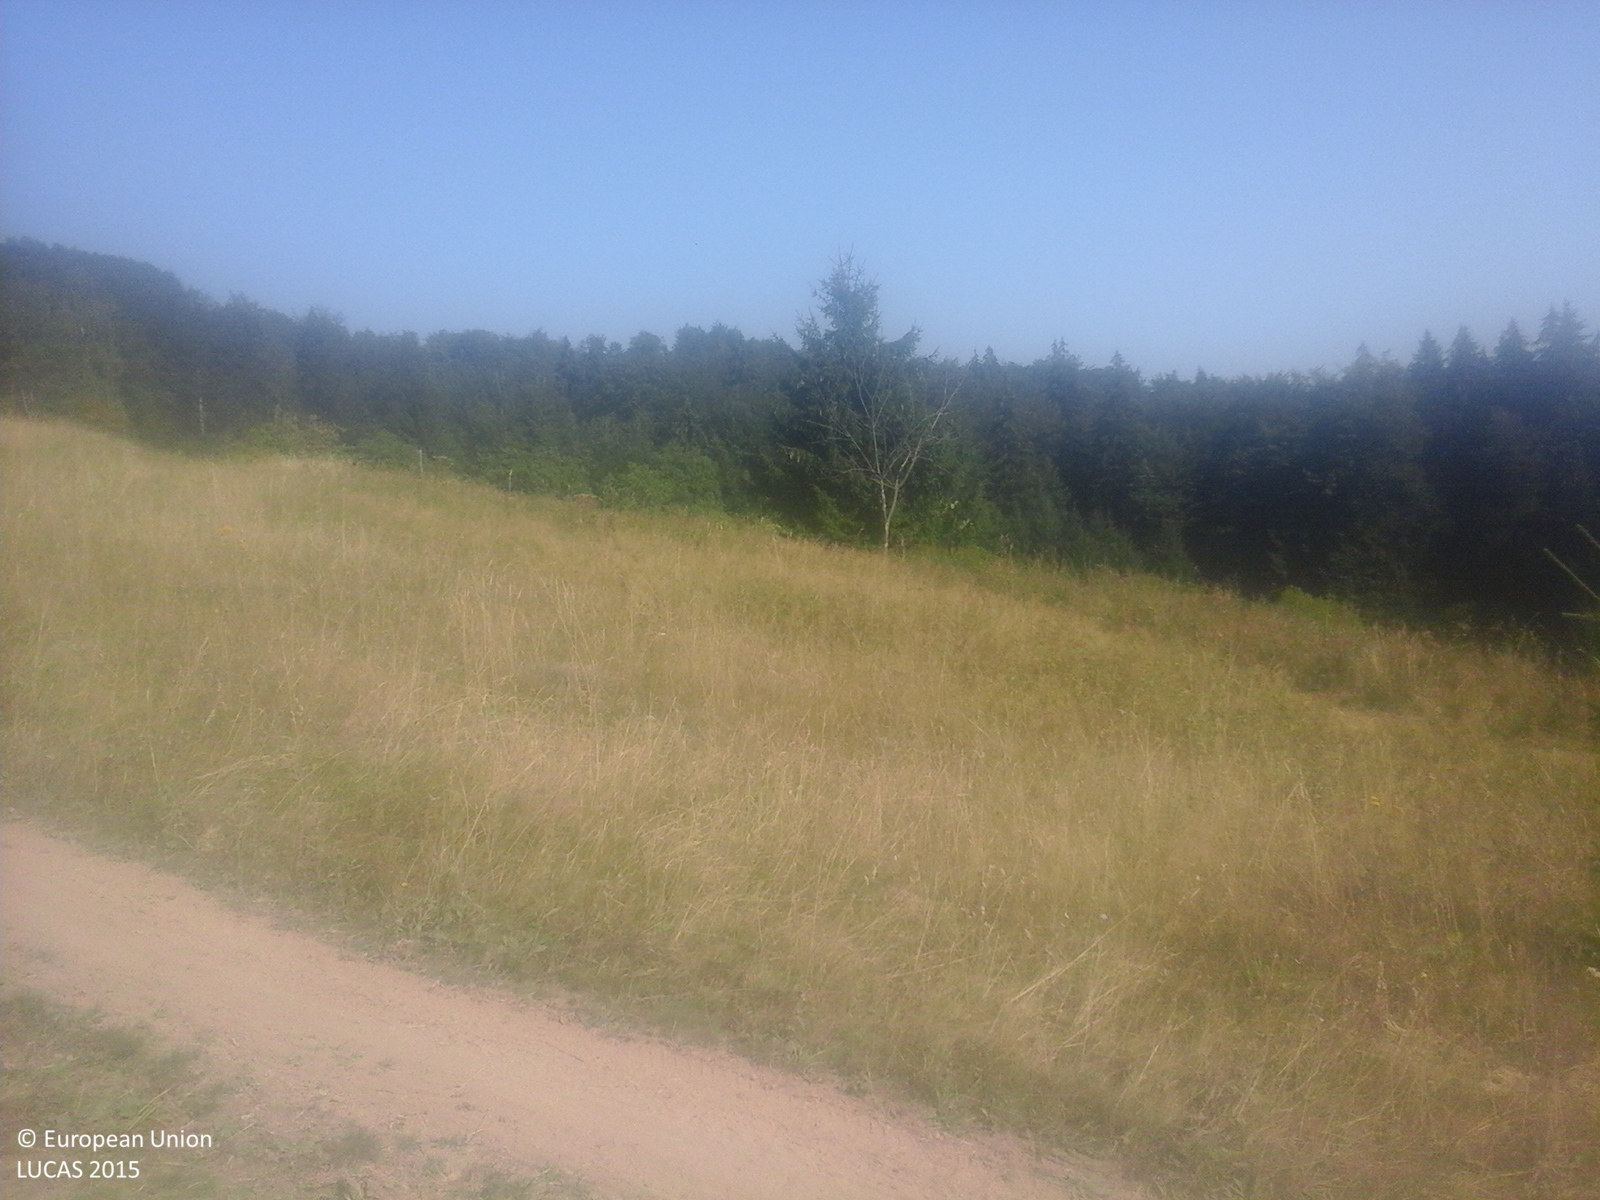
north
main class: Grassland
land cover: Grassland without tree/shrub cover
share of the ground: > 75 %
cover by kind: herbaceous plants 100 %
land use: Agriculture (excluding fallow land and kitchen gardens)
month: September
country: RO
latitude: 47.5845
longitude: 24.3853
